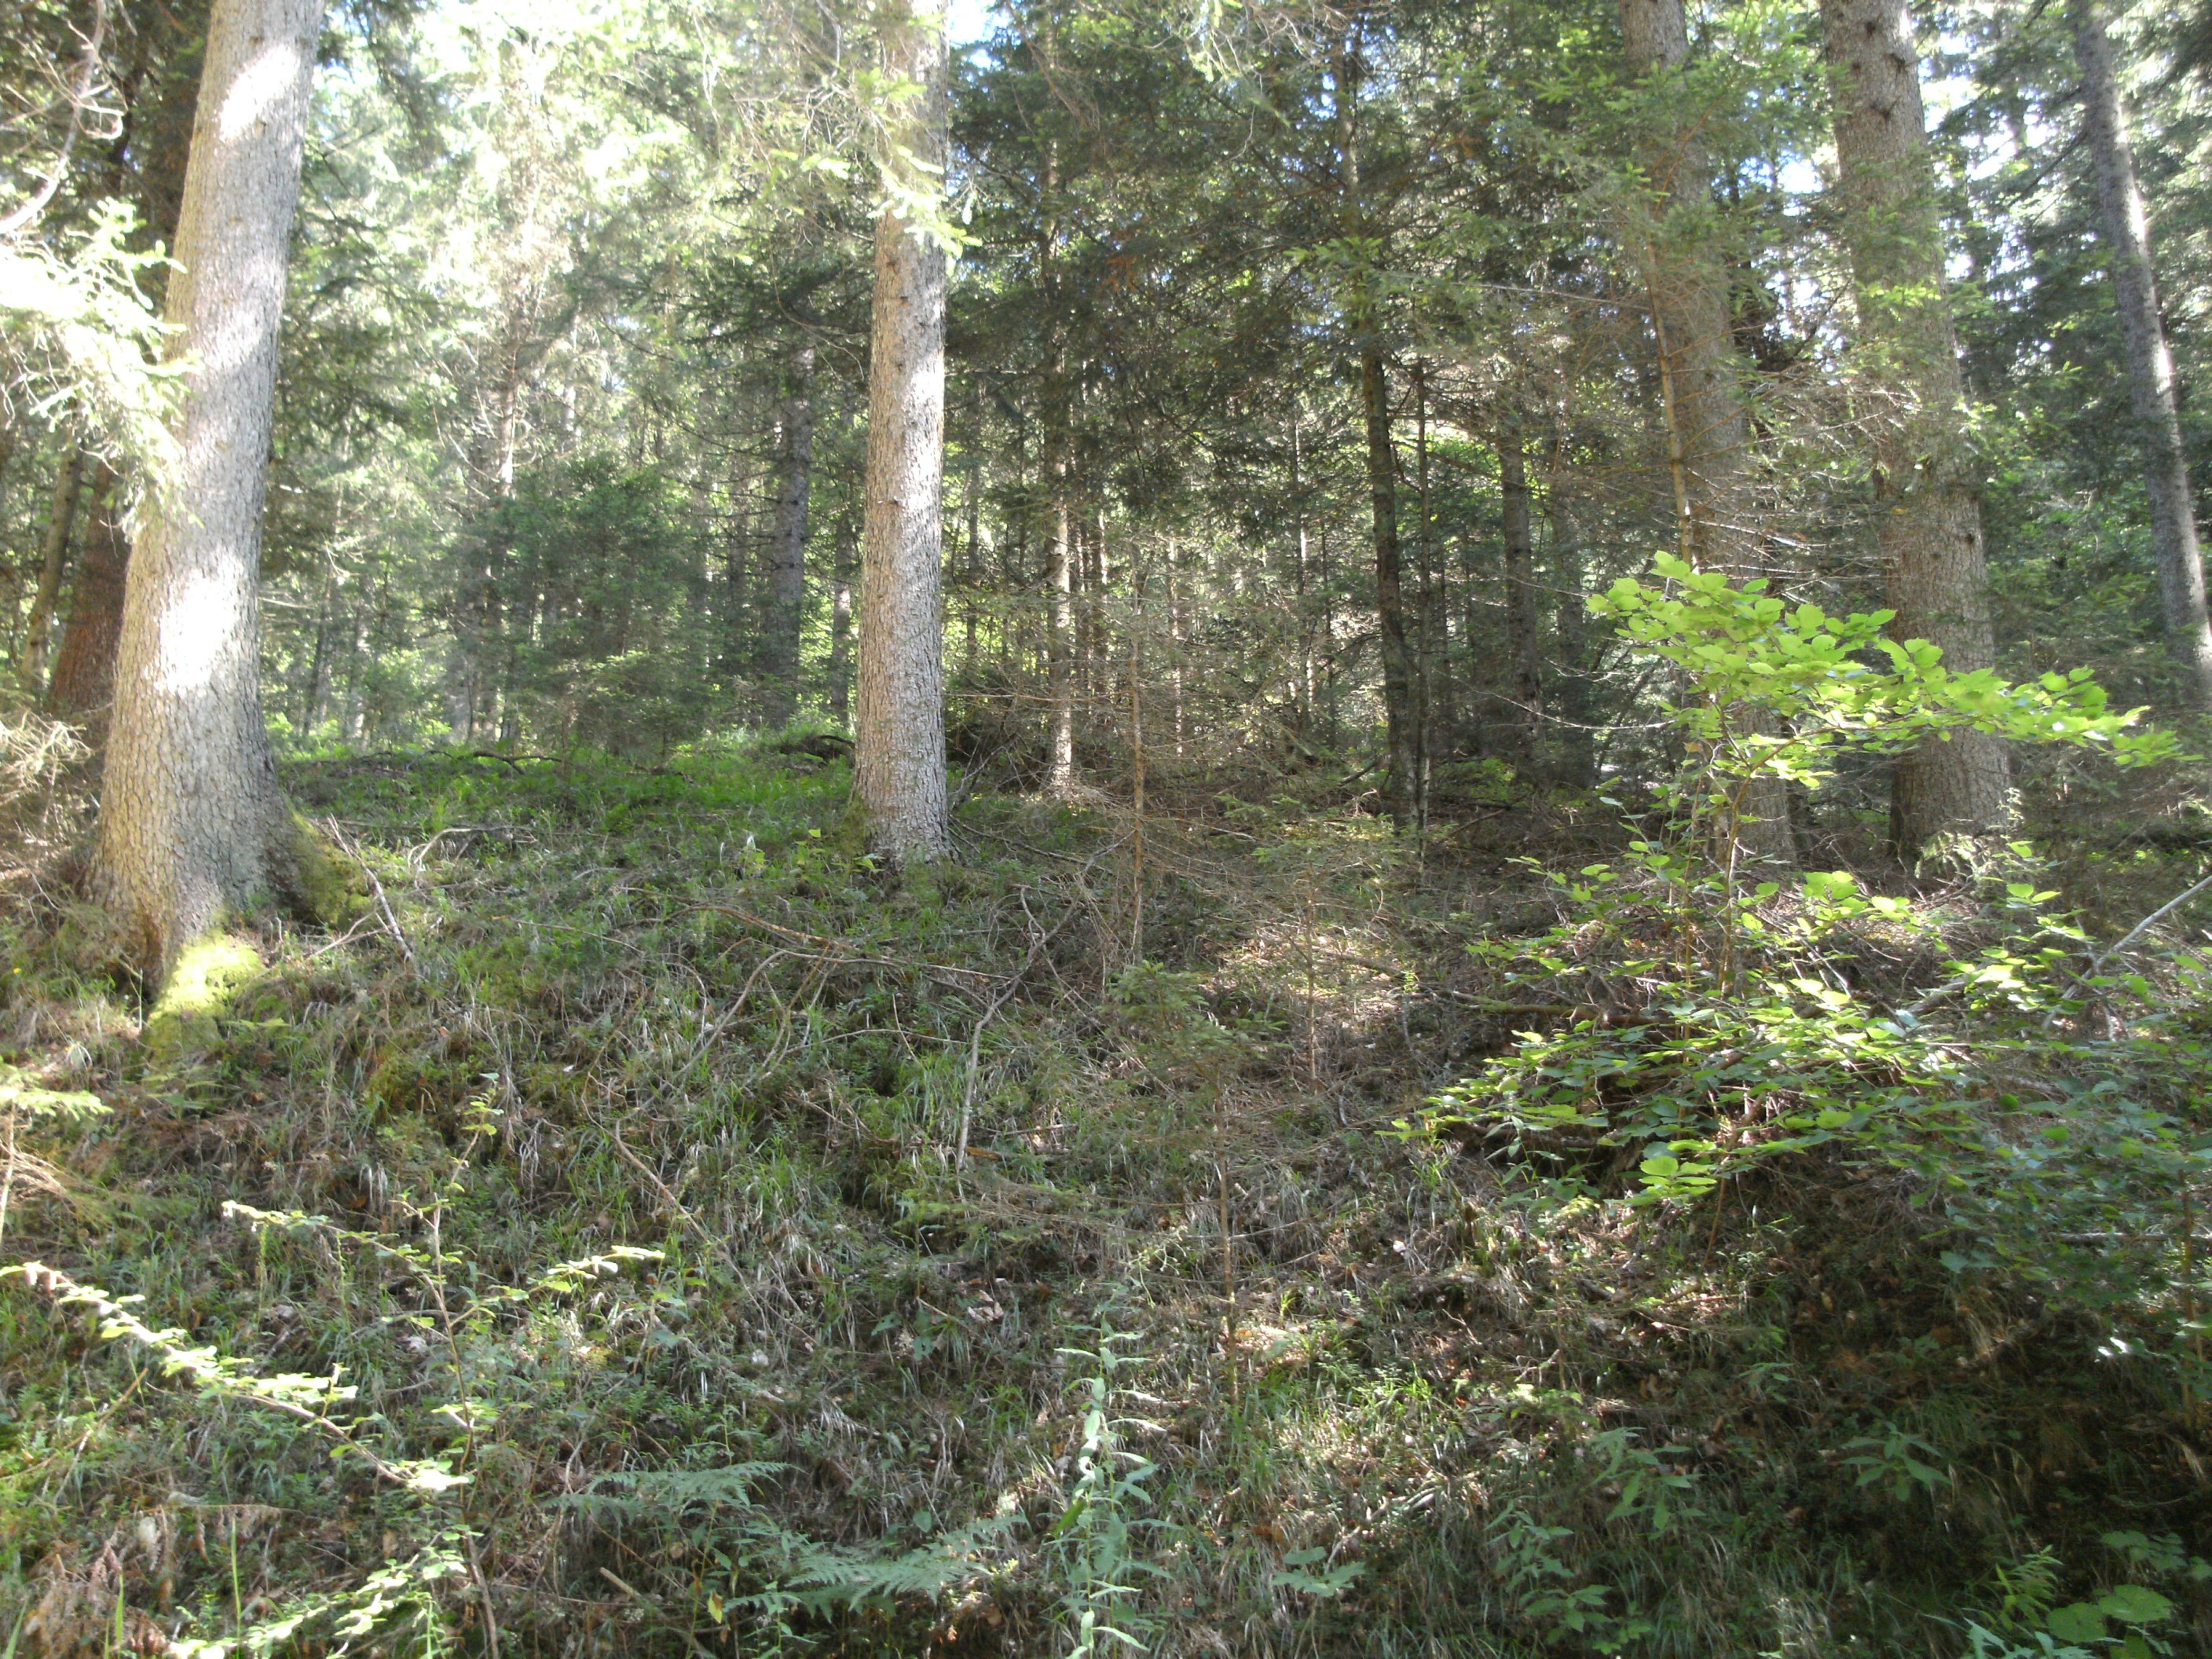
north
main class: Shrubland
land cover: Shrubland with sparse tree cover
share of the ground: 50 - 75 %
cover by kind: shrubs 65 %, unconsolidated bare surface 20 %, herbaceous plants 10 %, broadleaved forest trees 5 %
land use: Semi-natural and natural areas not in use
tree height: > 5 m
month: July
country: AT
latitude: 46.8609
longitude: 14.7073
